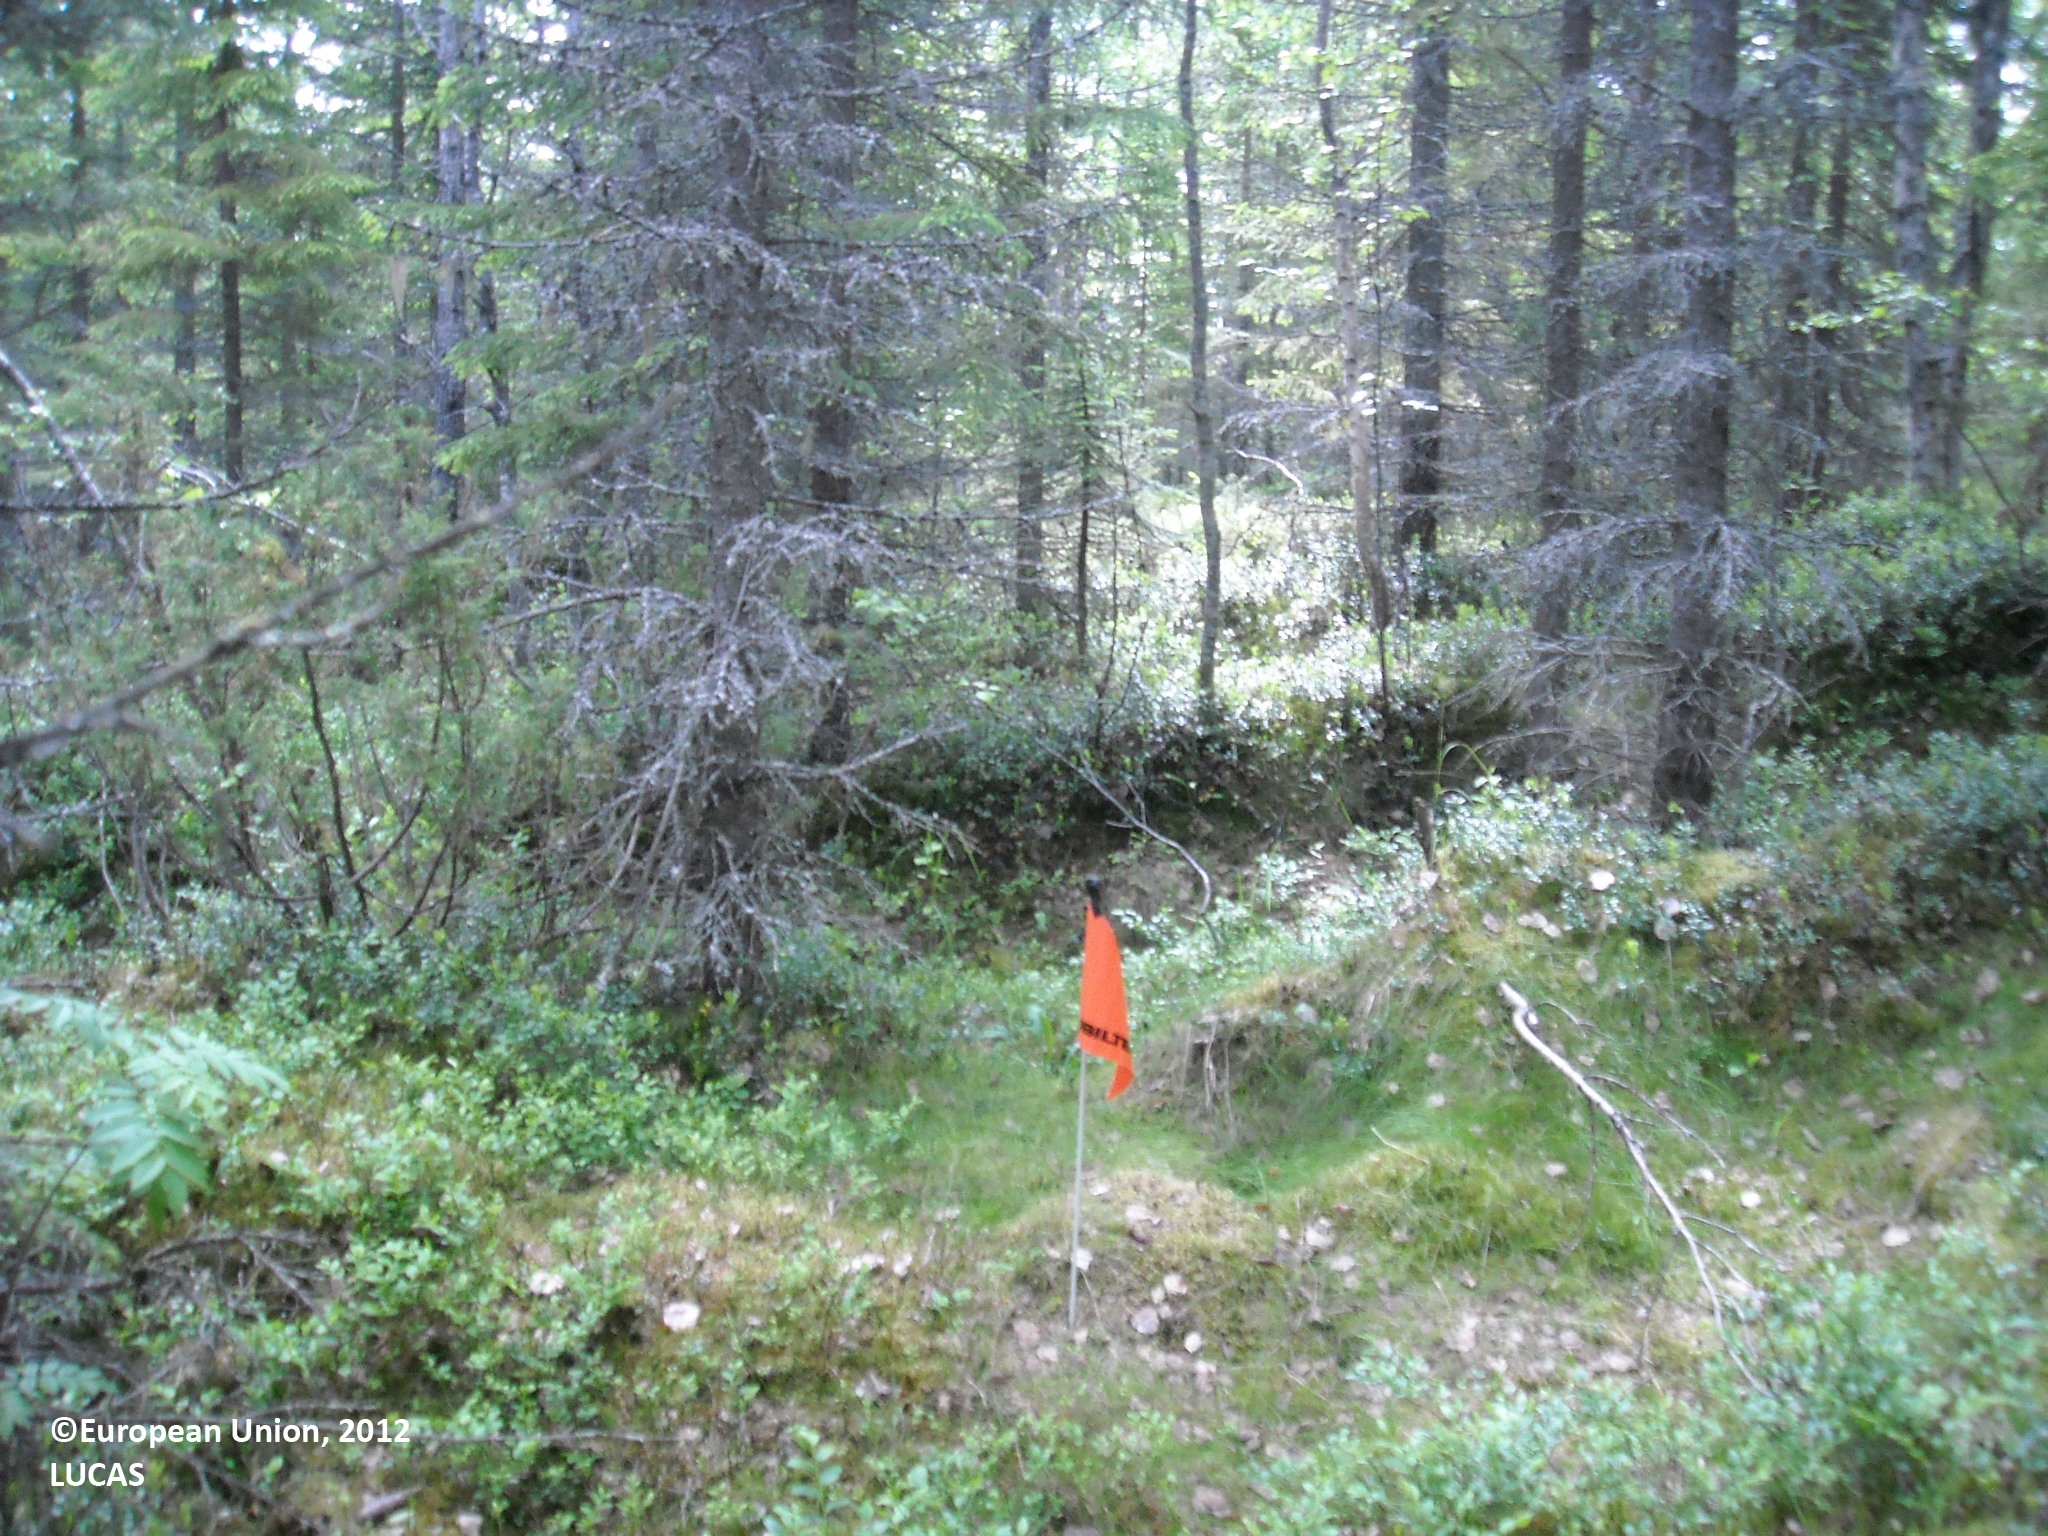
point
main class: Woodland
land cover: Spruce dominated coniferous woodland
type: boreal forest
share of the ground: > 75 %
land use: Forestry
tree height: > 5 m
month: June
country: FI
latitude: 64.8067
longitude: 27.8572
